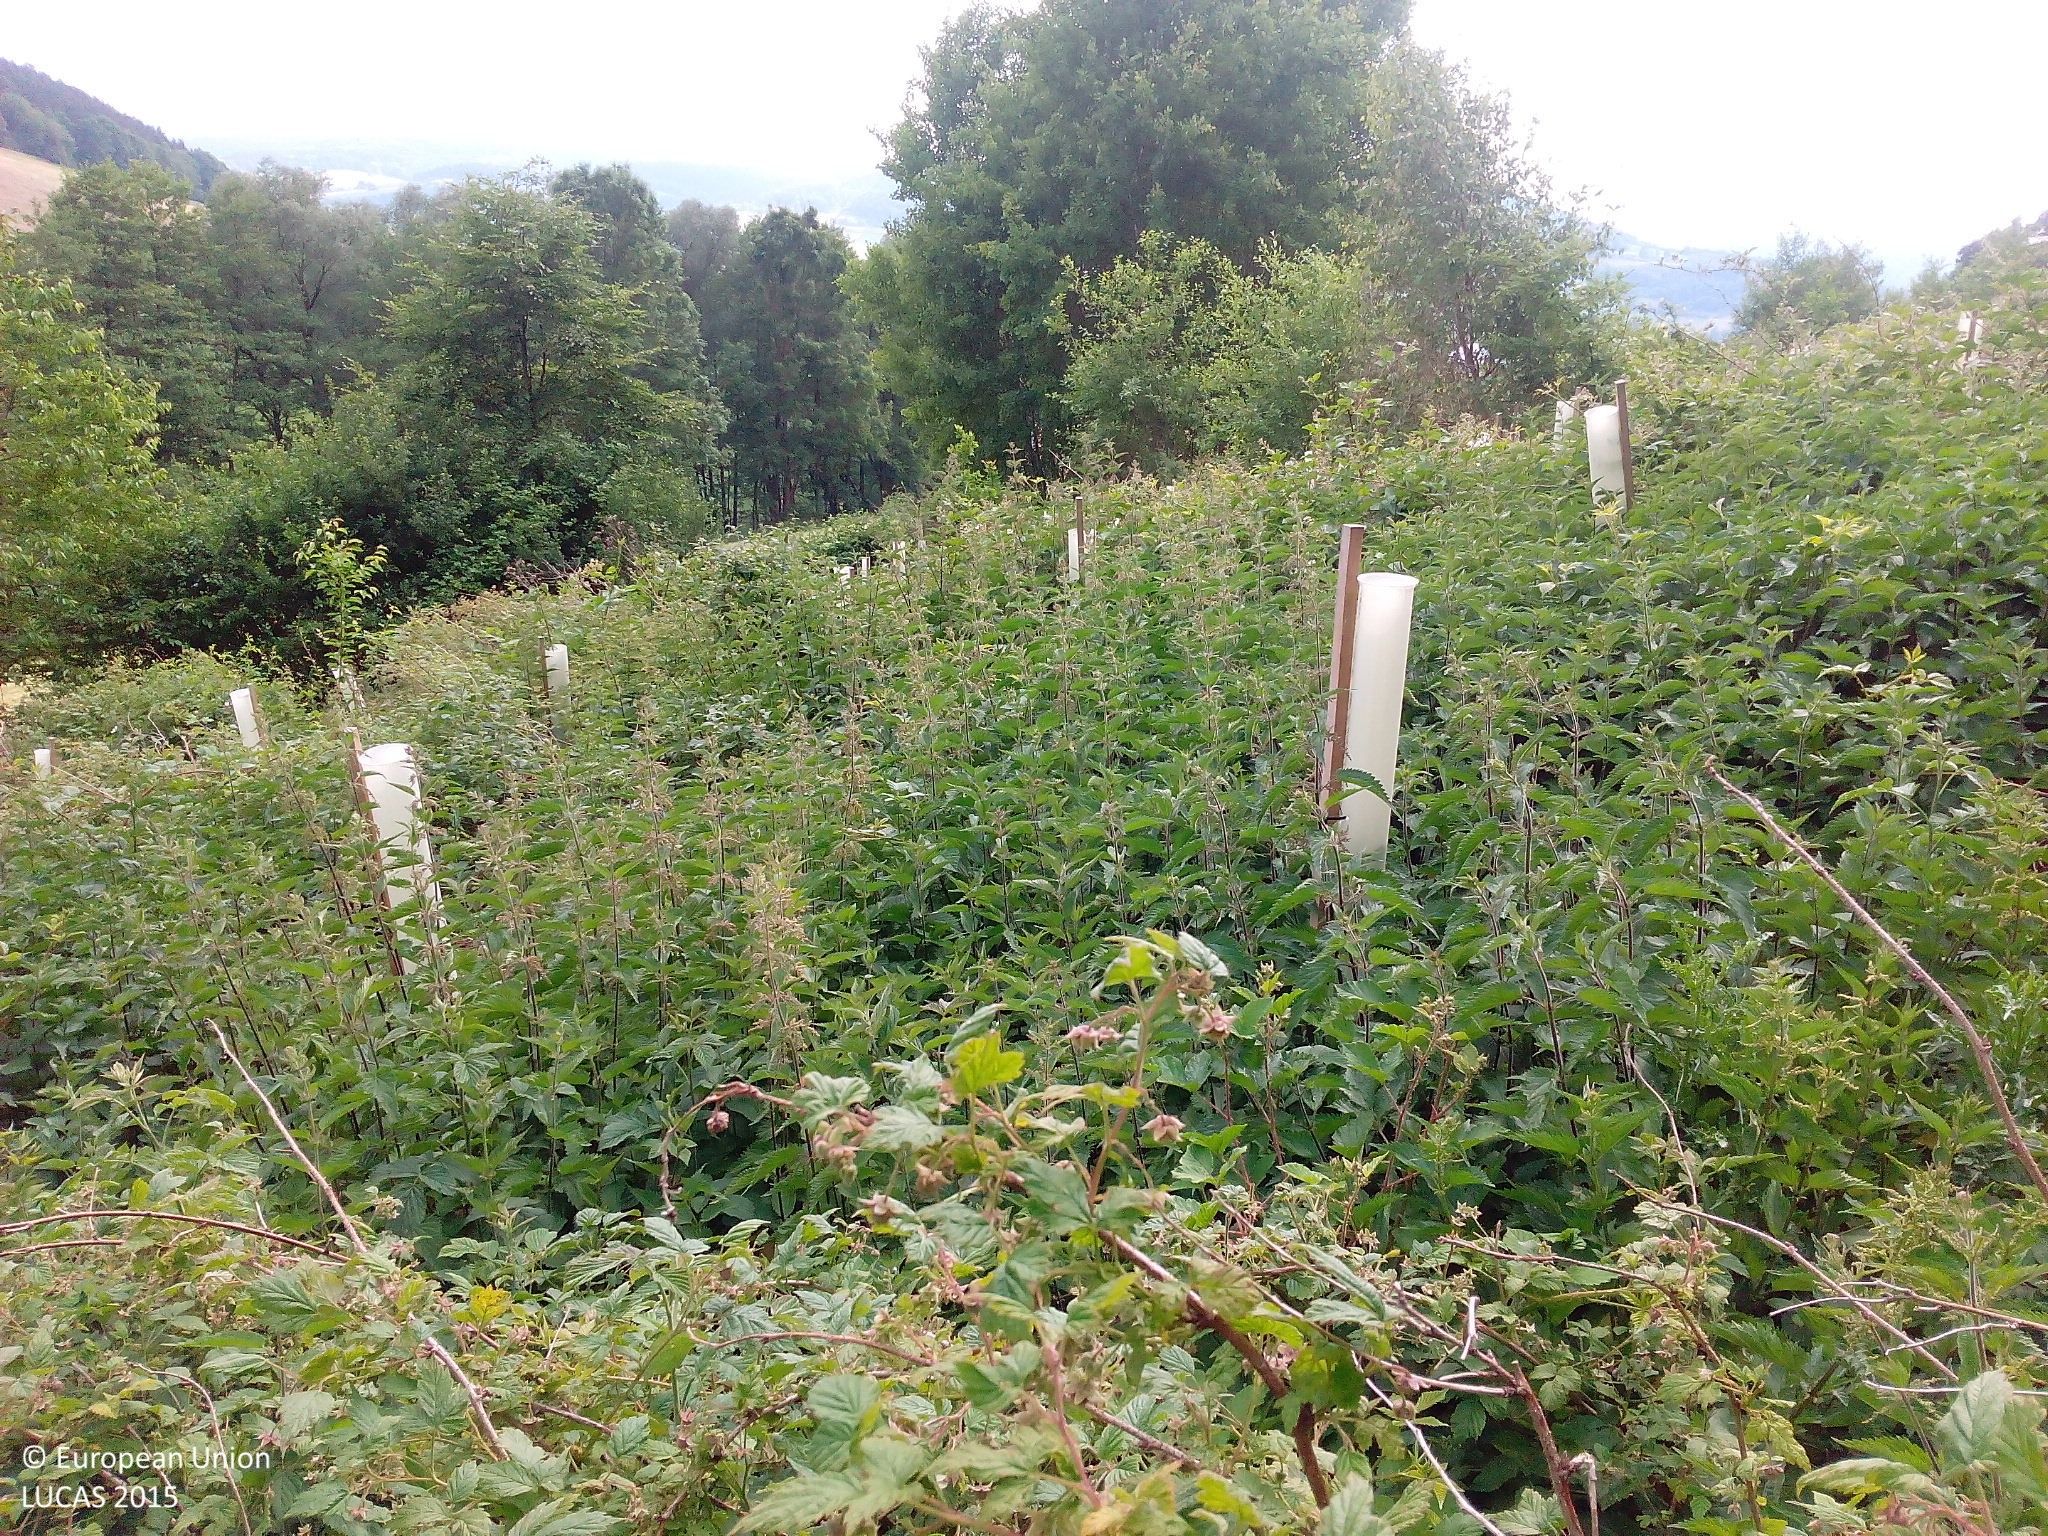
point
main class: Shrubland
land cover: Shrubland with sparse tree cover
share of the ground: > 75 %
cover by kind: herbaceous plants 55 %, shrubs 40 %, broadleaved forest trees 5 %
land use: Forestry
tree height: < 5 m
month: June
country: DE
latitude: 51.0647
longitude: 9.6434
